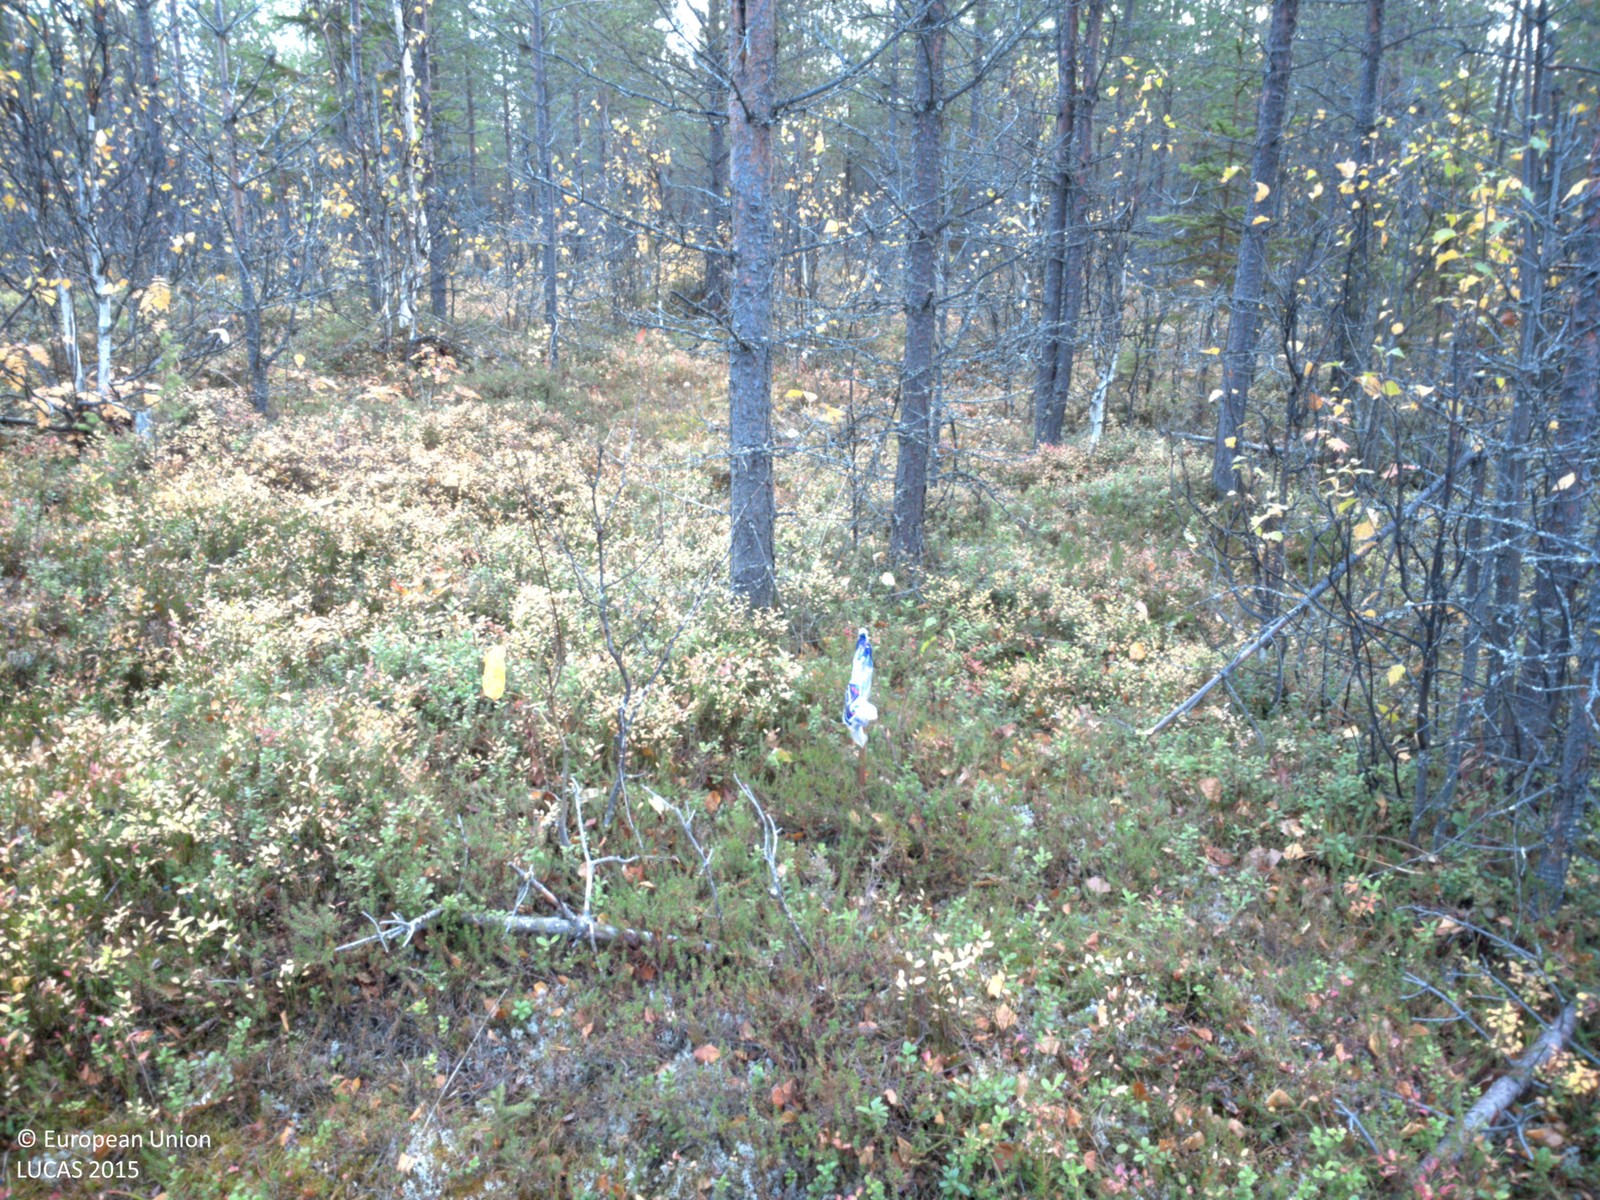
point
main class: Woodland
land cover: Pine dominated coniferous woodland
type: boreal forest
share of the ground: 50 - 75 %
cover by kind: coniferous forest trees 65 %, shrubs 20 %, broadleaved forest trees 5 %, herbaceous plants 5 %, lichens and mosses 5 %
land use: Forestry
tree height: < 5 m
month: October
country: SE
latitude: 64.6787
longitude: 18.1599
